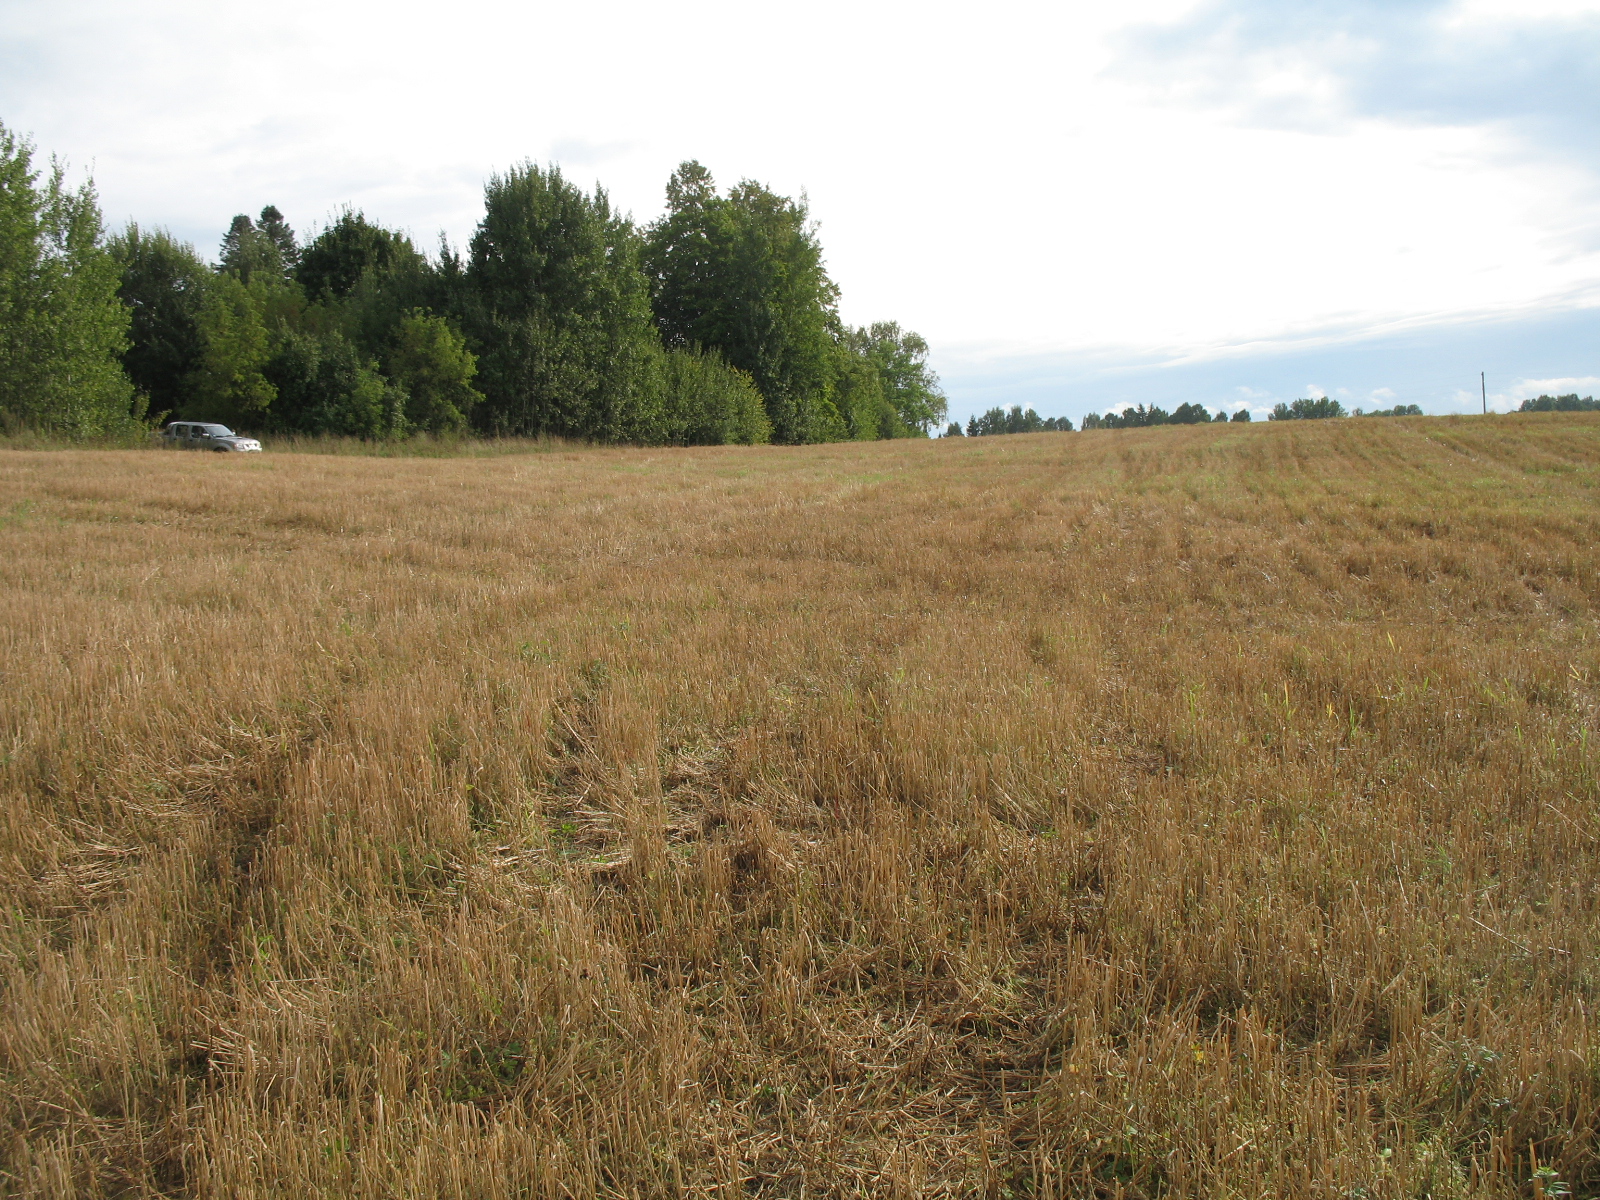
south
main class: Cropland
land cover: Common wheat
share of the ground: 10 - 25 %
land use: Agriculture (excluding fallow land and kitchen gardens)
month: September
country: LV
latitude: 56.0833
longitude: 25.9297
